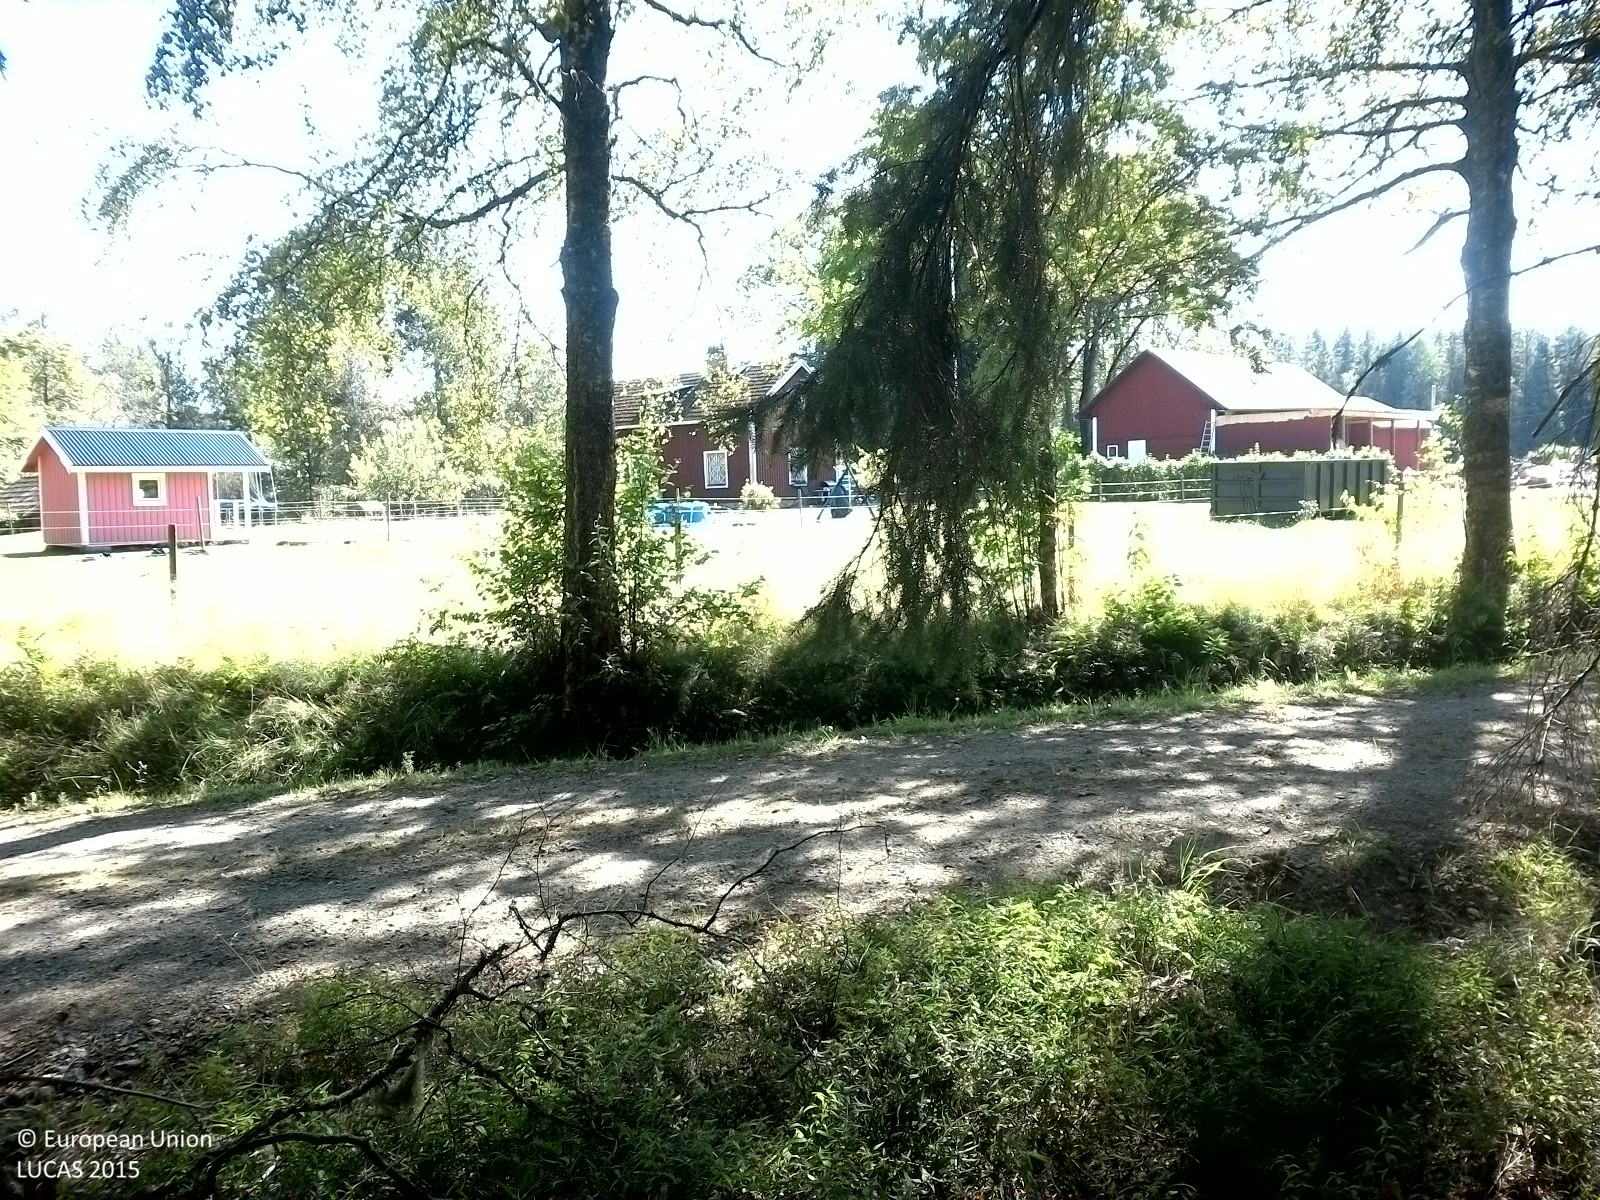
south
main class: Woodland
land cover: Spruce dominated coniferous woodland
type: boreal forest
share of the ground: 50 - 75 %
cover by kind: coniferous forest trees 55 %, lichens and mosses 25 %, herbaceous plants 20 %
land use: Forestry
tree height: > 5 m
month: August
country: SE
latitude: 59.4203
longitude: 15.1194
